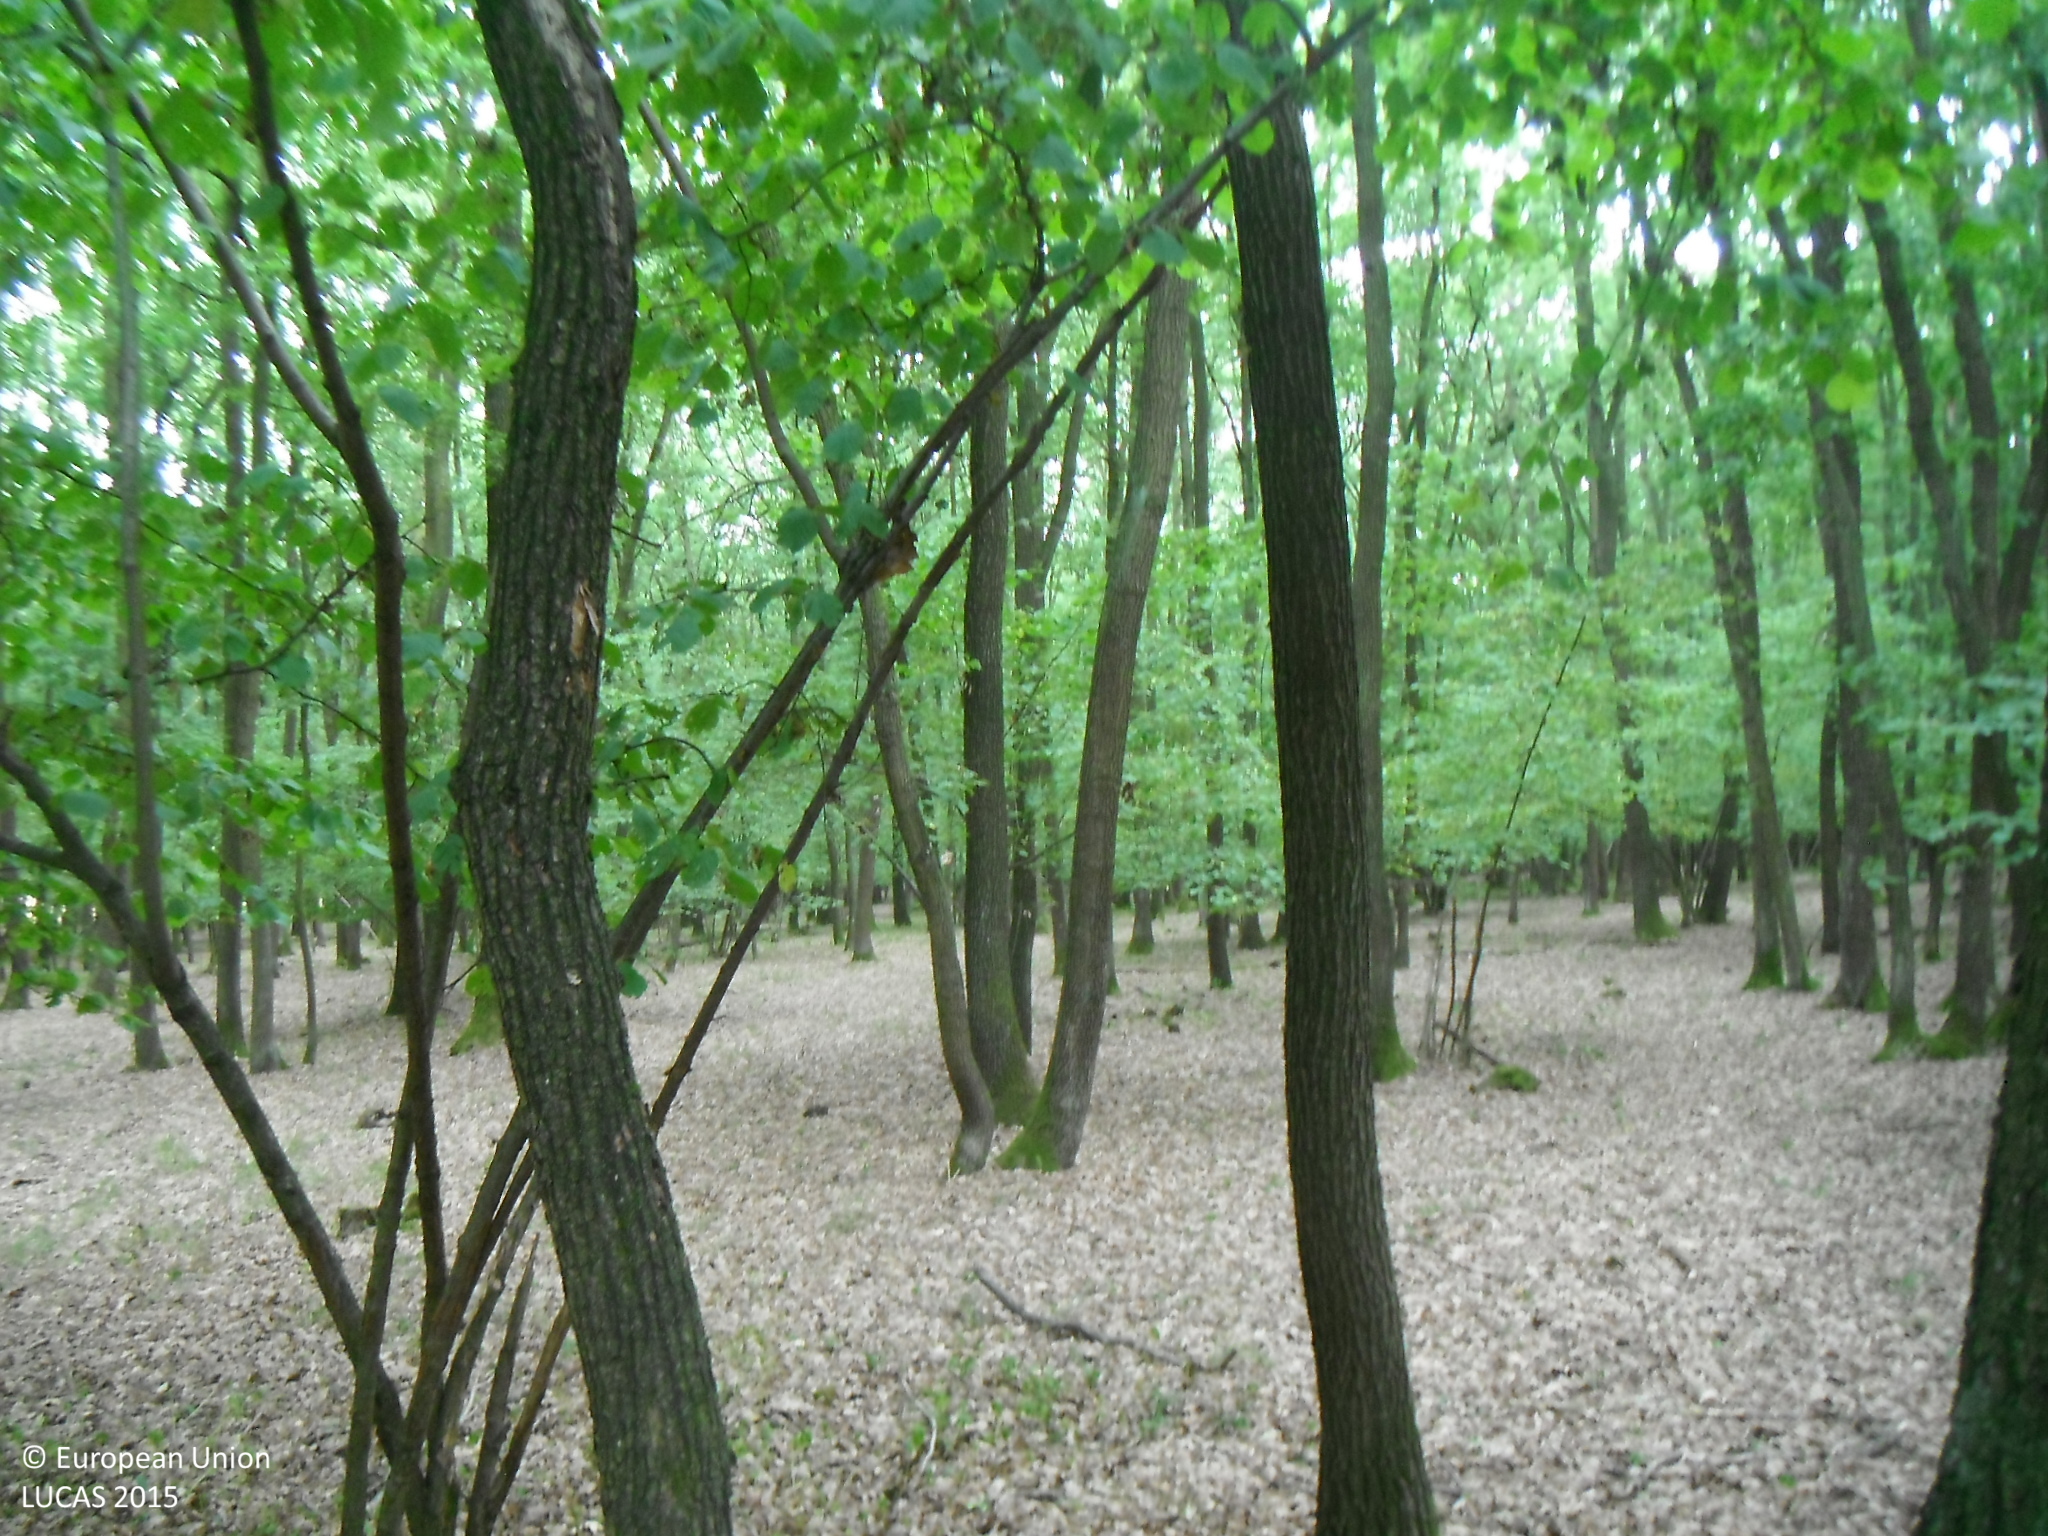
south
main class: Woodland
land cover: Broadleaved woodland
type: mesophytic deciduous forest
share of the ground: > 75 %
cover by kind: broadleaved forest trees 90 %, herbaceous plants 5 %, unconsolidated bare surface 5 %
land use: Forestry
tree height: > 5 m
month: July
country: SK
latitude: 48.7965
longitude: 17.2659
